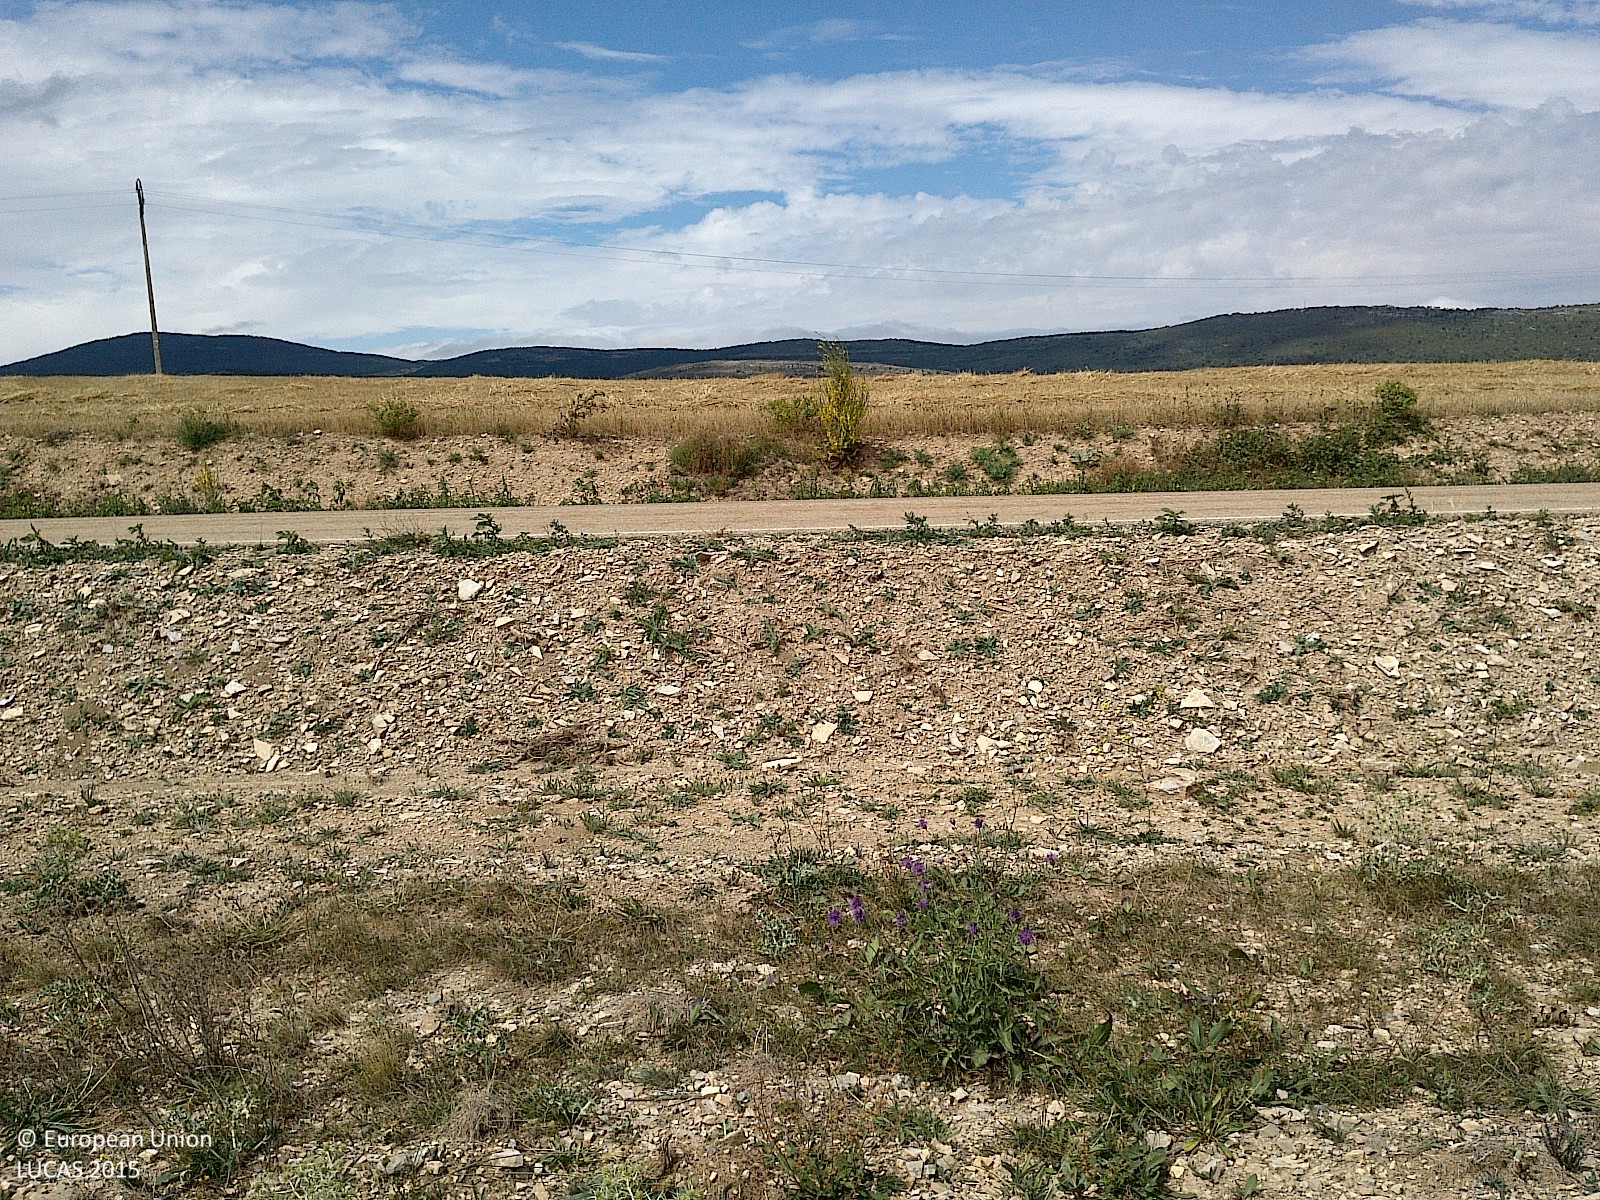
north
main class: Grassland
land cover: Grassland without tree/shrub cover
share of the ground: > 75 %
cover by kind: herbaceous plants 80 %, unconsolidated bare surface 15 %, shrubs 5 %
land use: Semi-natural and natural areas not in use
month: July
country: ES
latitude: 42.0173
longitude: -2.2470
